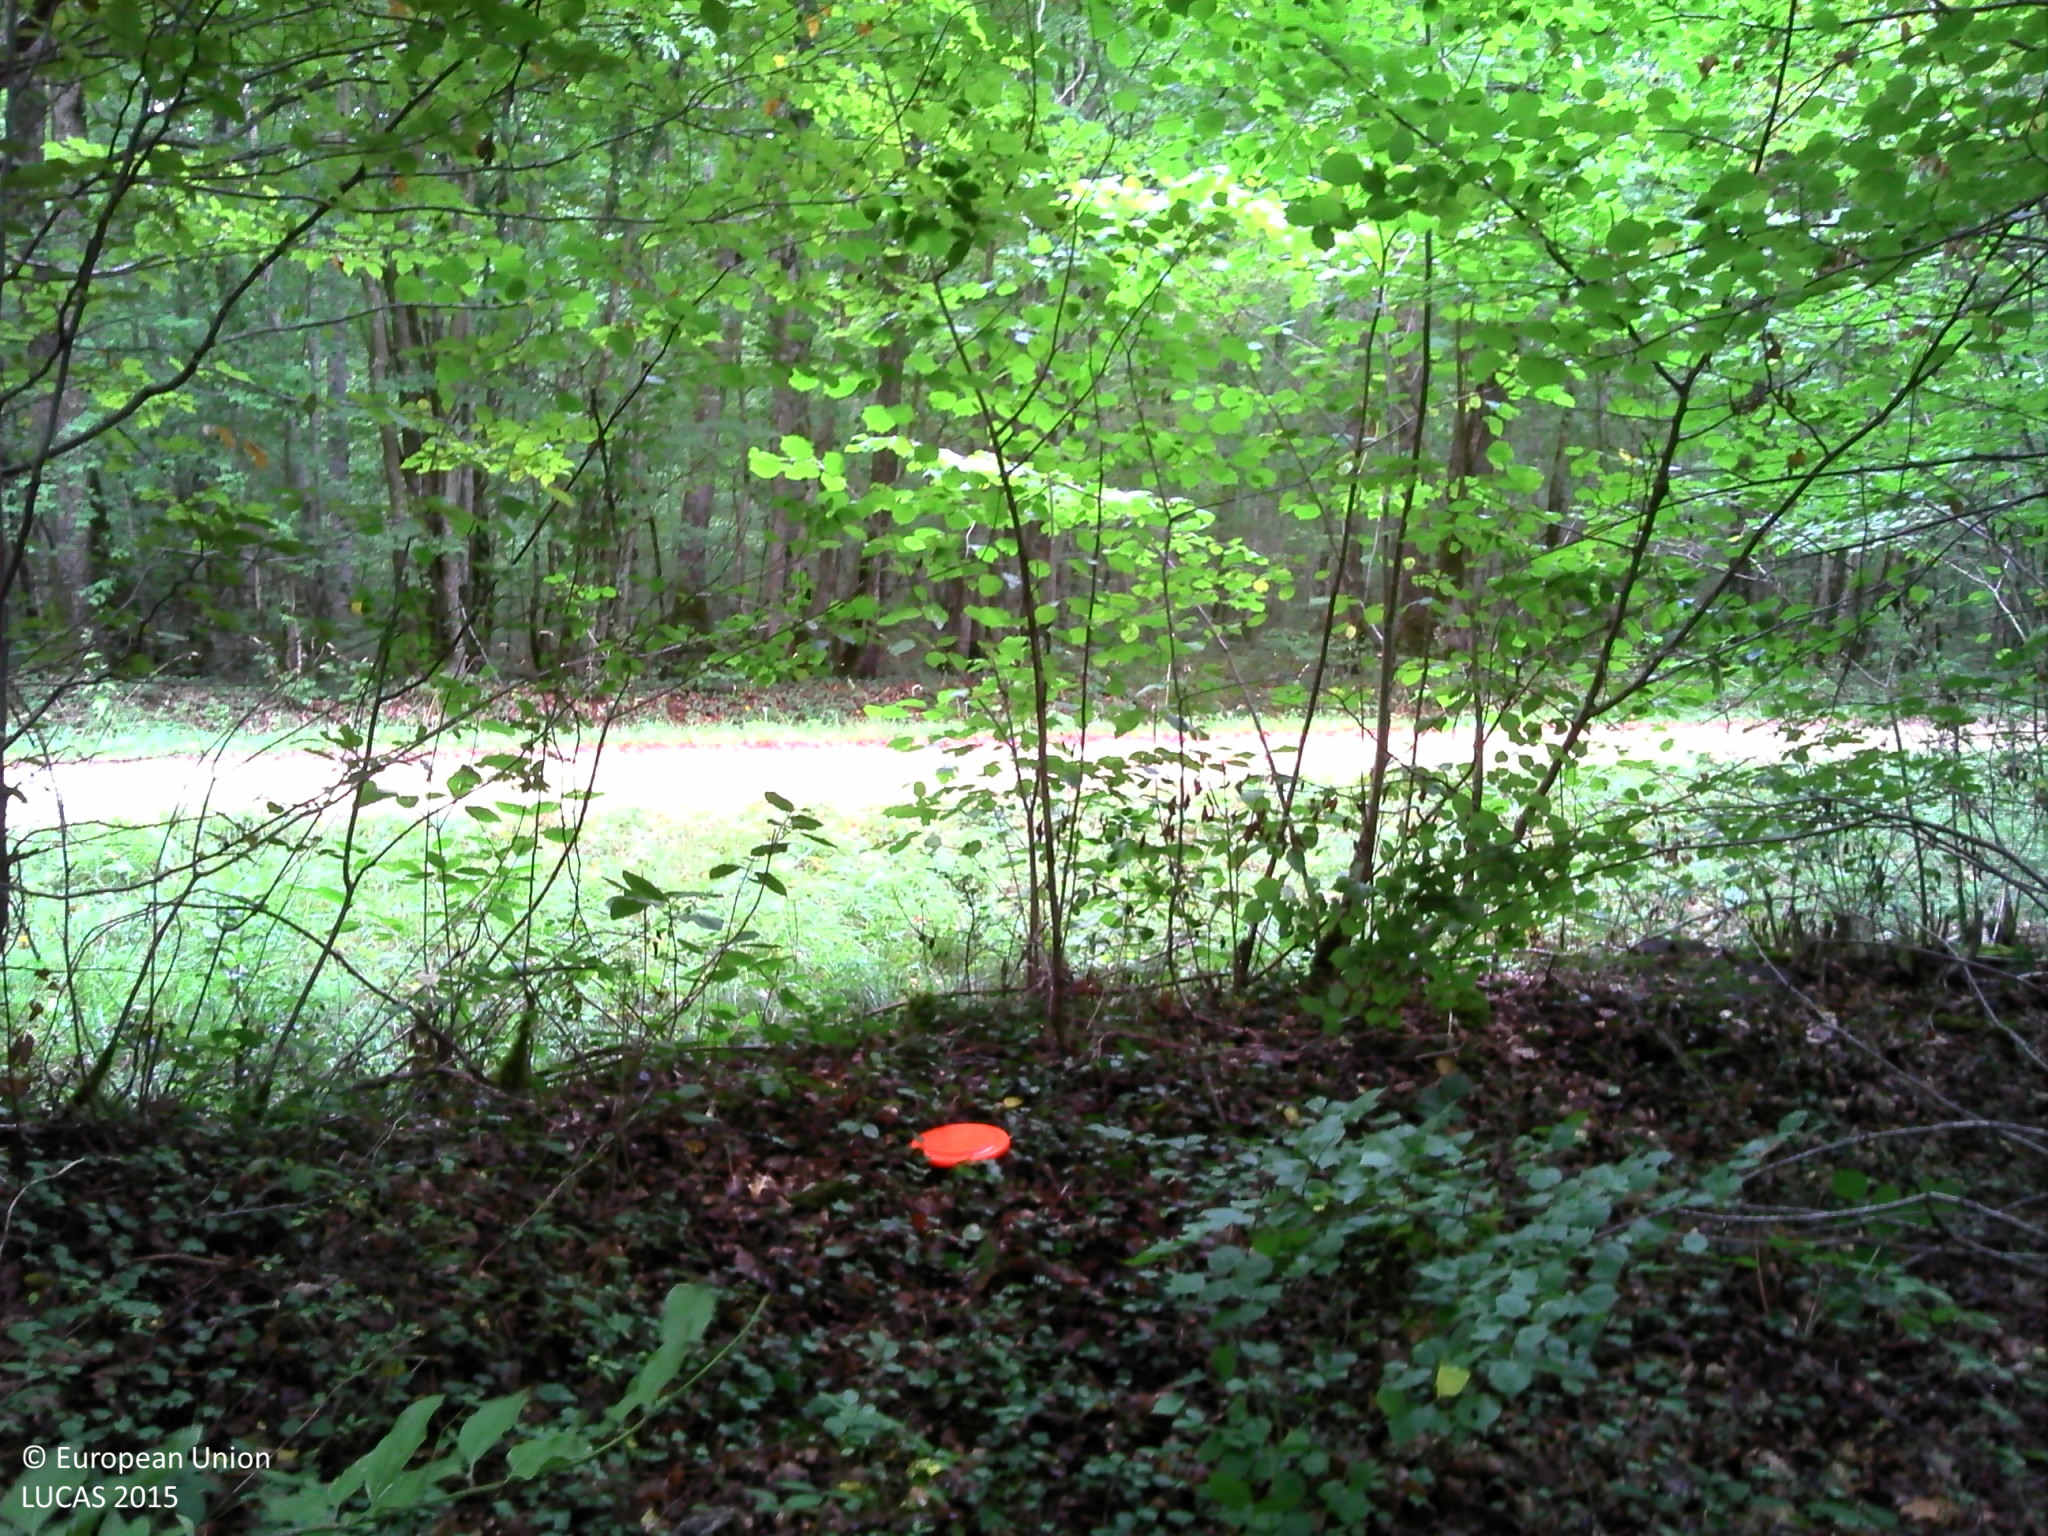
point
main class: Woodland
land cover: Broadleaved woodland
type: mesophytic deciduous forest
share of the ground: > 75 %
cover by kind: broadleaved forest trees 85 %, shrubs 5 %, herbaceous plants 5 %, lichens and mosses 5 %
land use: Forestry
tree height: > 5 m
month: August
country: FR
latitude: 47.9035
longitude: 4.8218
